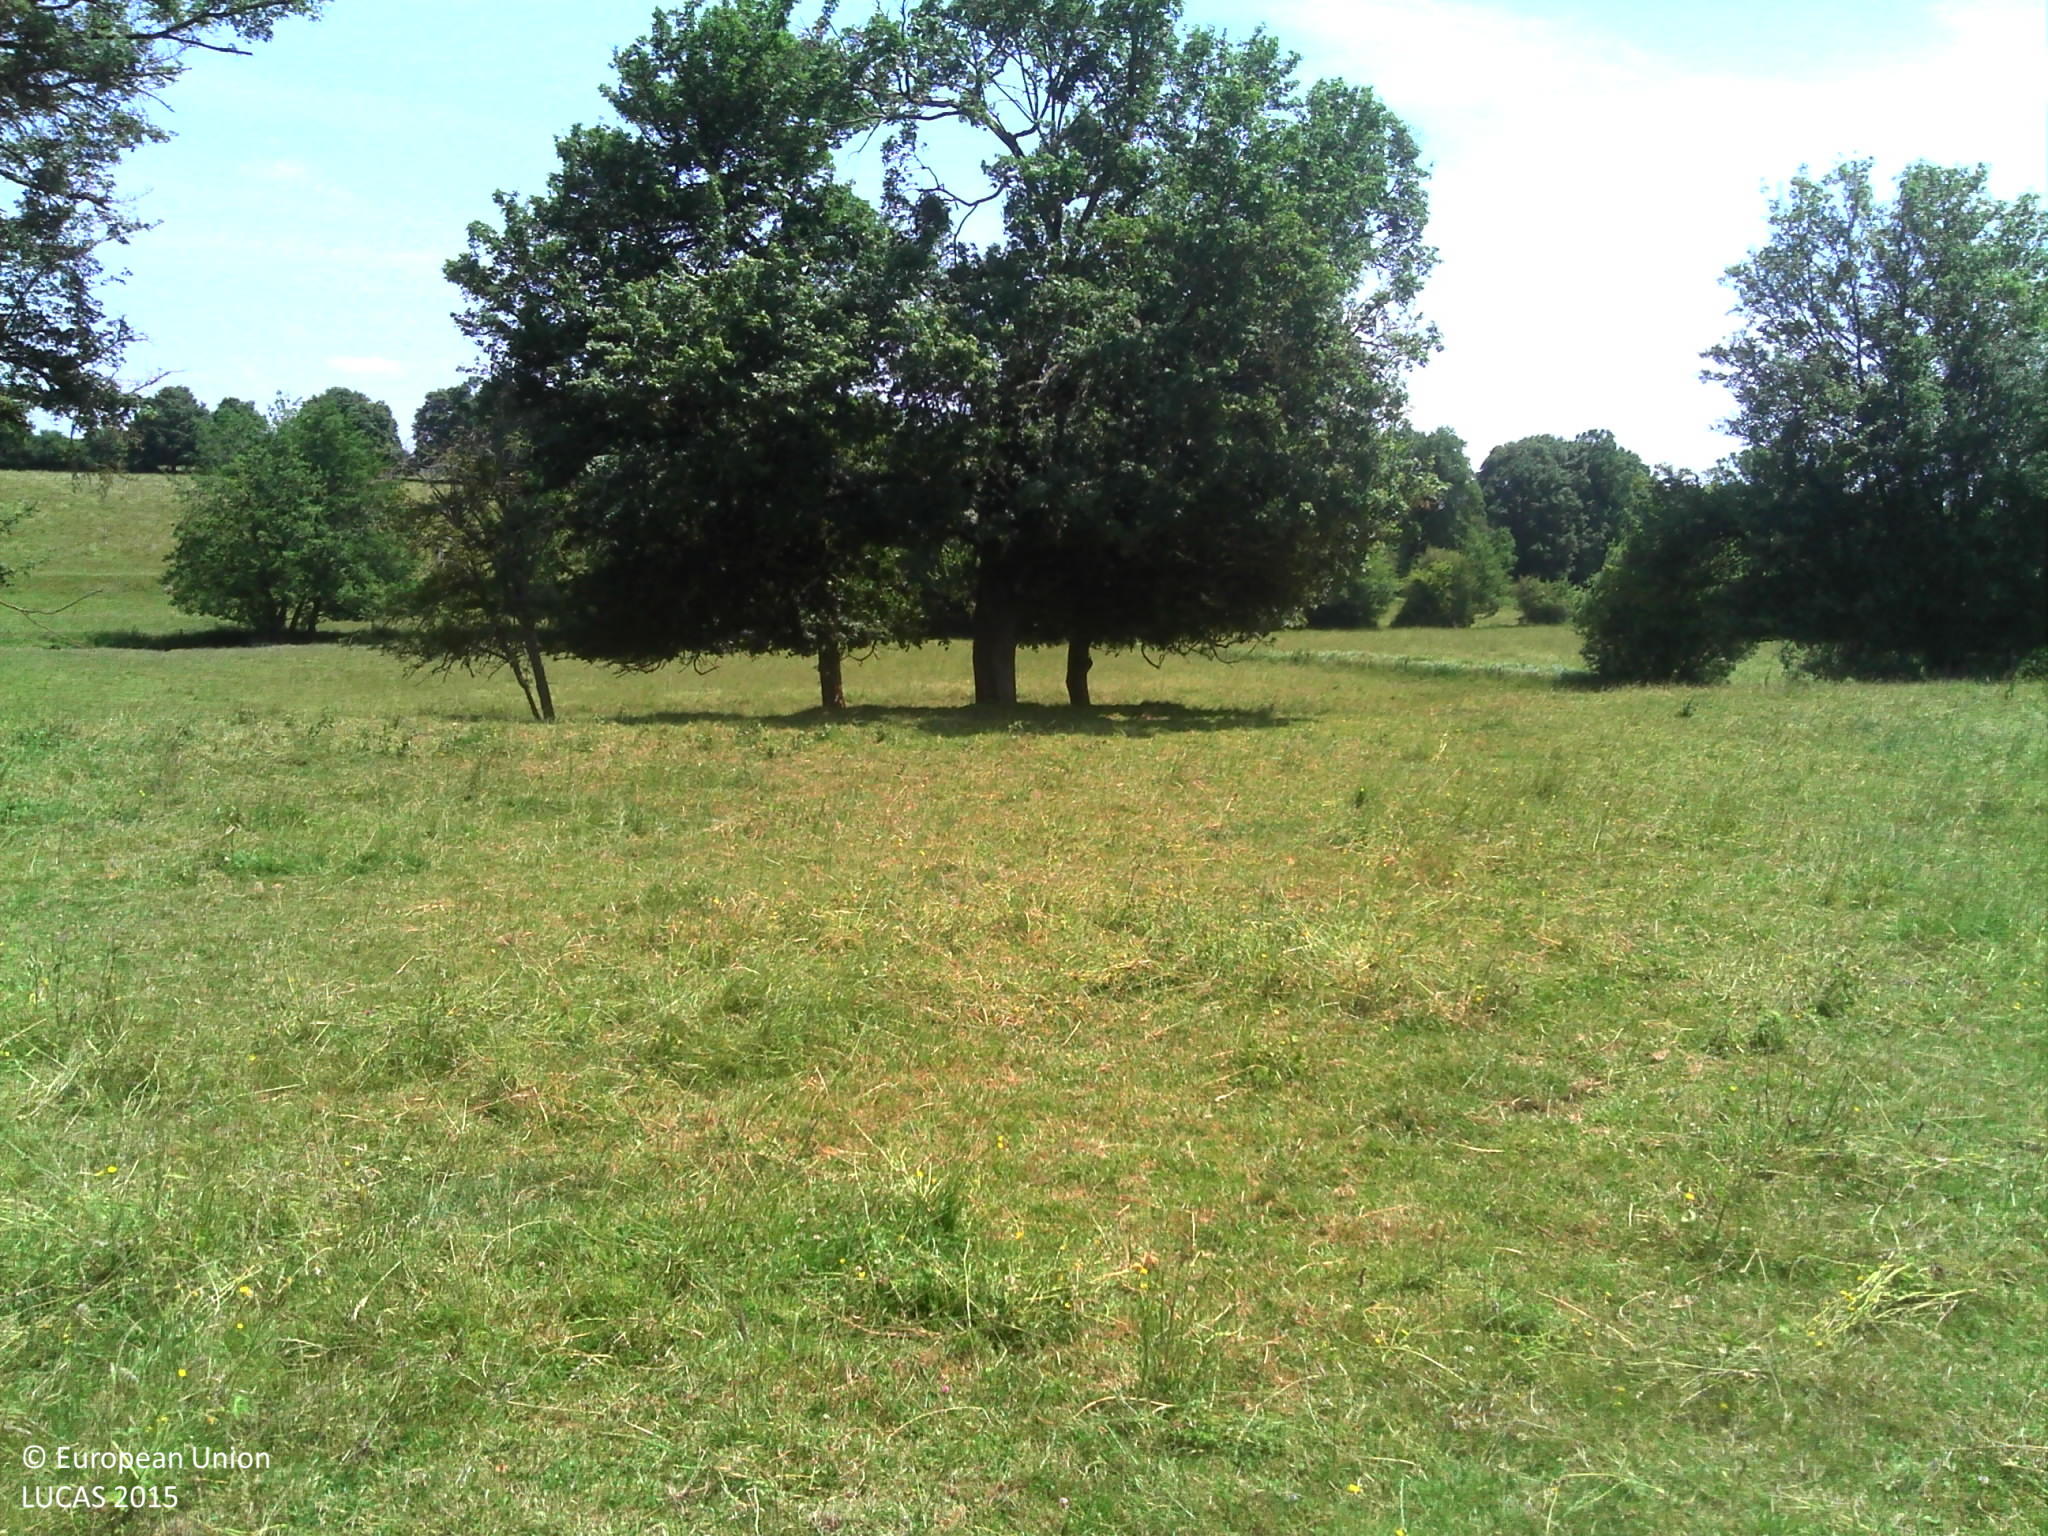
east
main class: Grassland
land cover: Grassland with sparse tree/shrub cover
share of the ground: > 75 %
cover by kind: herbaceous plants 95 %, broadleaved forest trees 5 %
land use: Agriculture (excluding fallow land and kitchen gardens)
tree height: > 5 m
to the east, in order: Grassland with sparse tree/shrub cover; Lines of trees; Grassland with sparse tree/shrub cover; Single bushes/trees; Rivers and streams; Fences; Grassland without tree/shrub cover
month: June
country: FR
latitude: 47.2169
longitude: 3.1690
